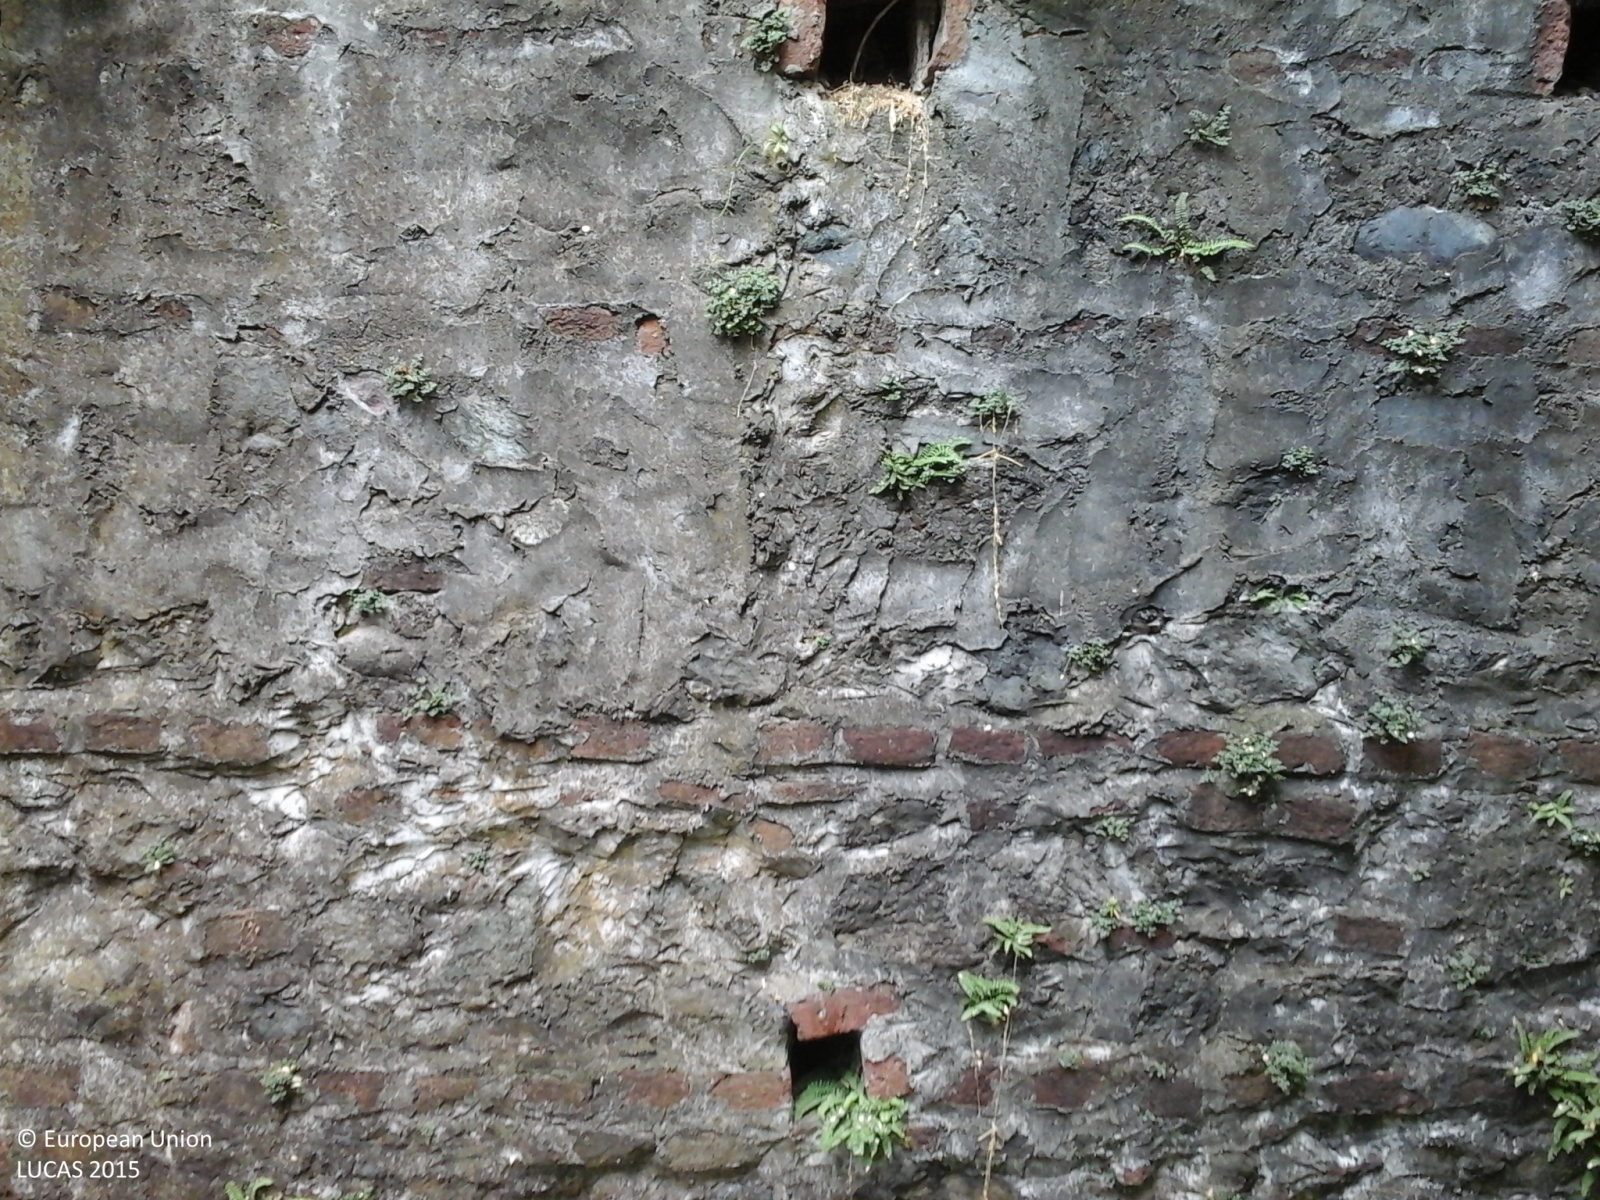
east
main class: Woodland
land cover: Broadleaved woodland
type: thermophilous deciduous forest
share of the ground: > 75 %
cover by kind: broadleaved forest trees 100 %
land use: Semi-natural and natural areas not in use
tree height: > 5 m
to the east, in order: Broadleaved woodland; Fences; Tracks; Artificial constructions in urban areas; Broadleaved woodland; Permanent crops (only in case pi)
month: June
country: IT
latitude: 45.1024
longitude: 7.7799
